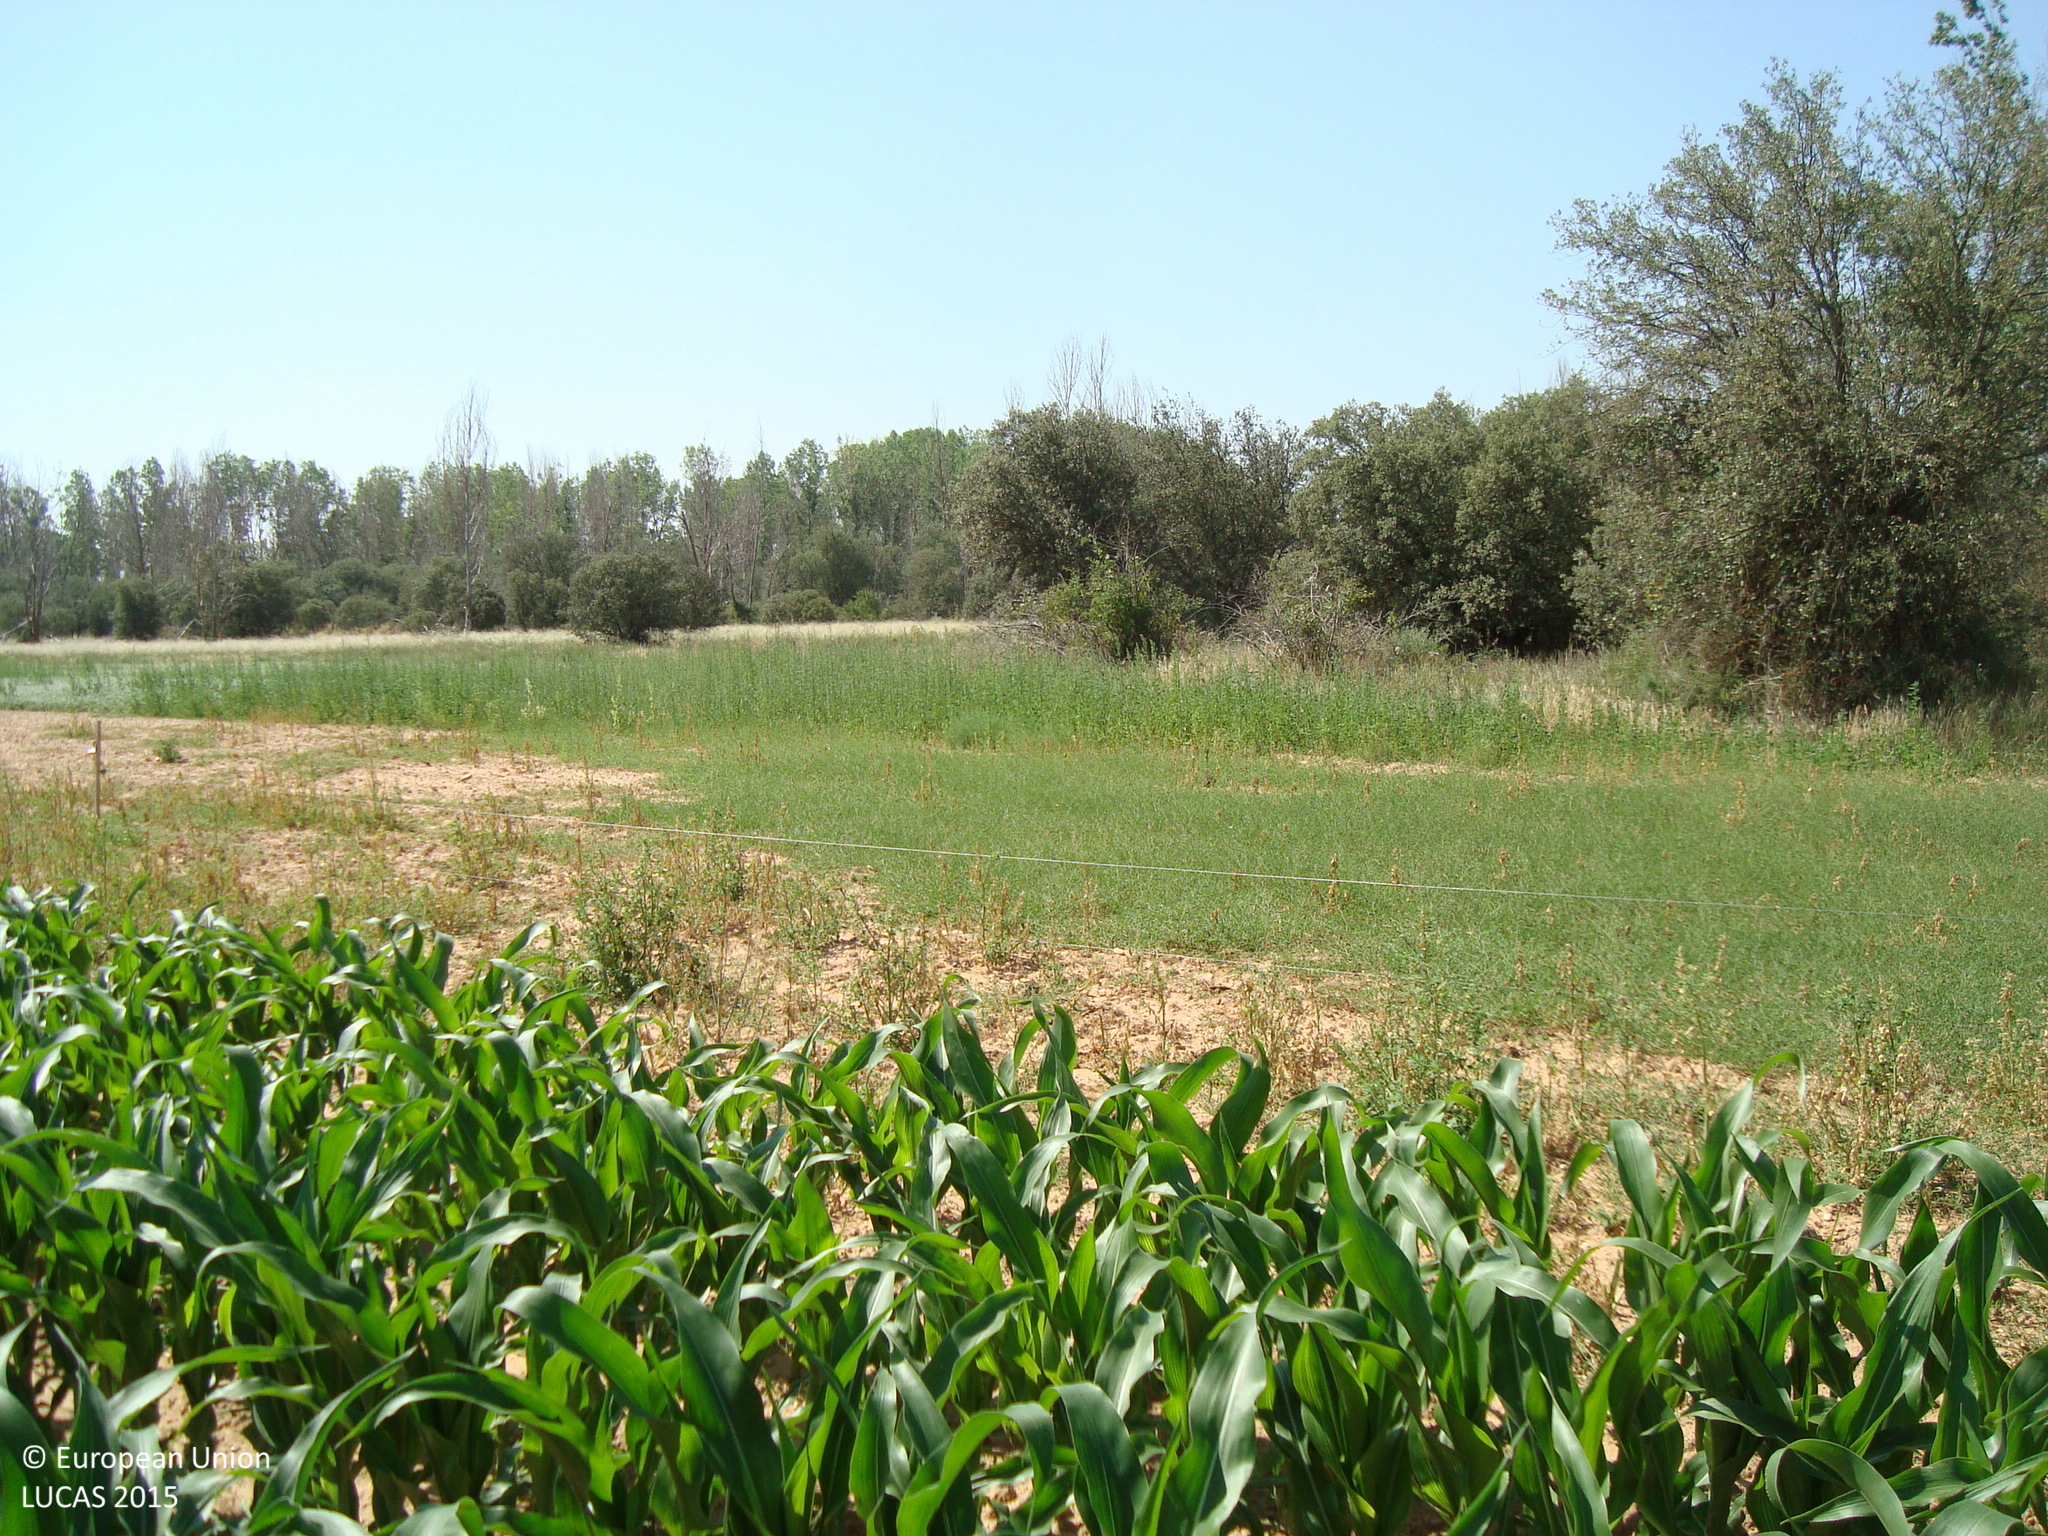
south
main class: Cropland
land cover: Maize
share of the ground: > 75 %
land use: Agriculture (excluding fallow land and kitchen gardens)
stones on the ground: < 10 %
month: June
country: ES
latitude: 41.6957
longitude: -3.8617
